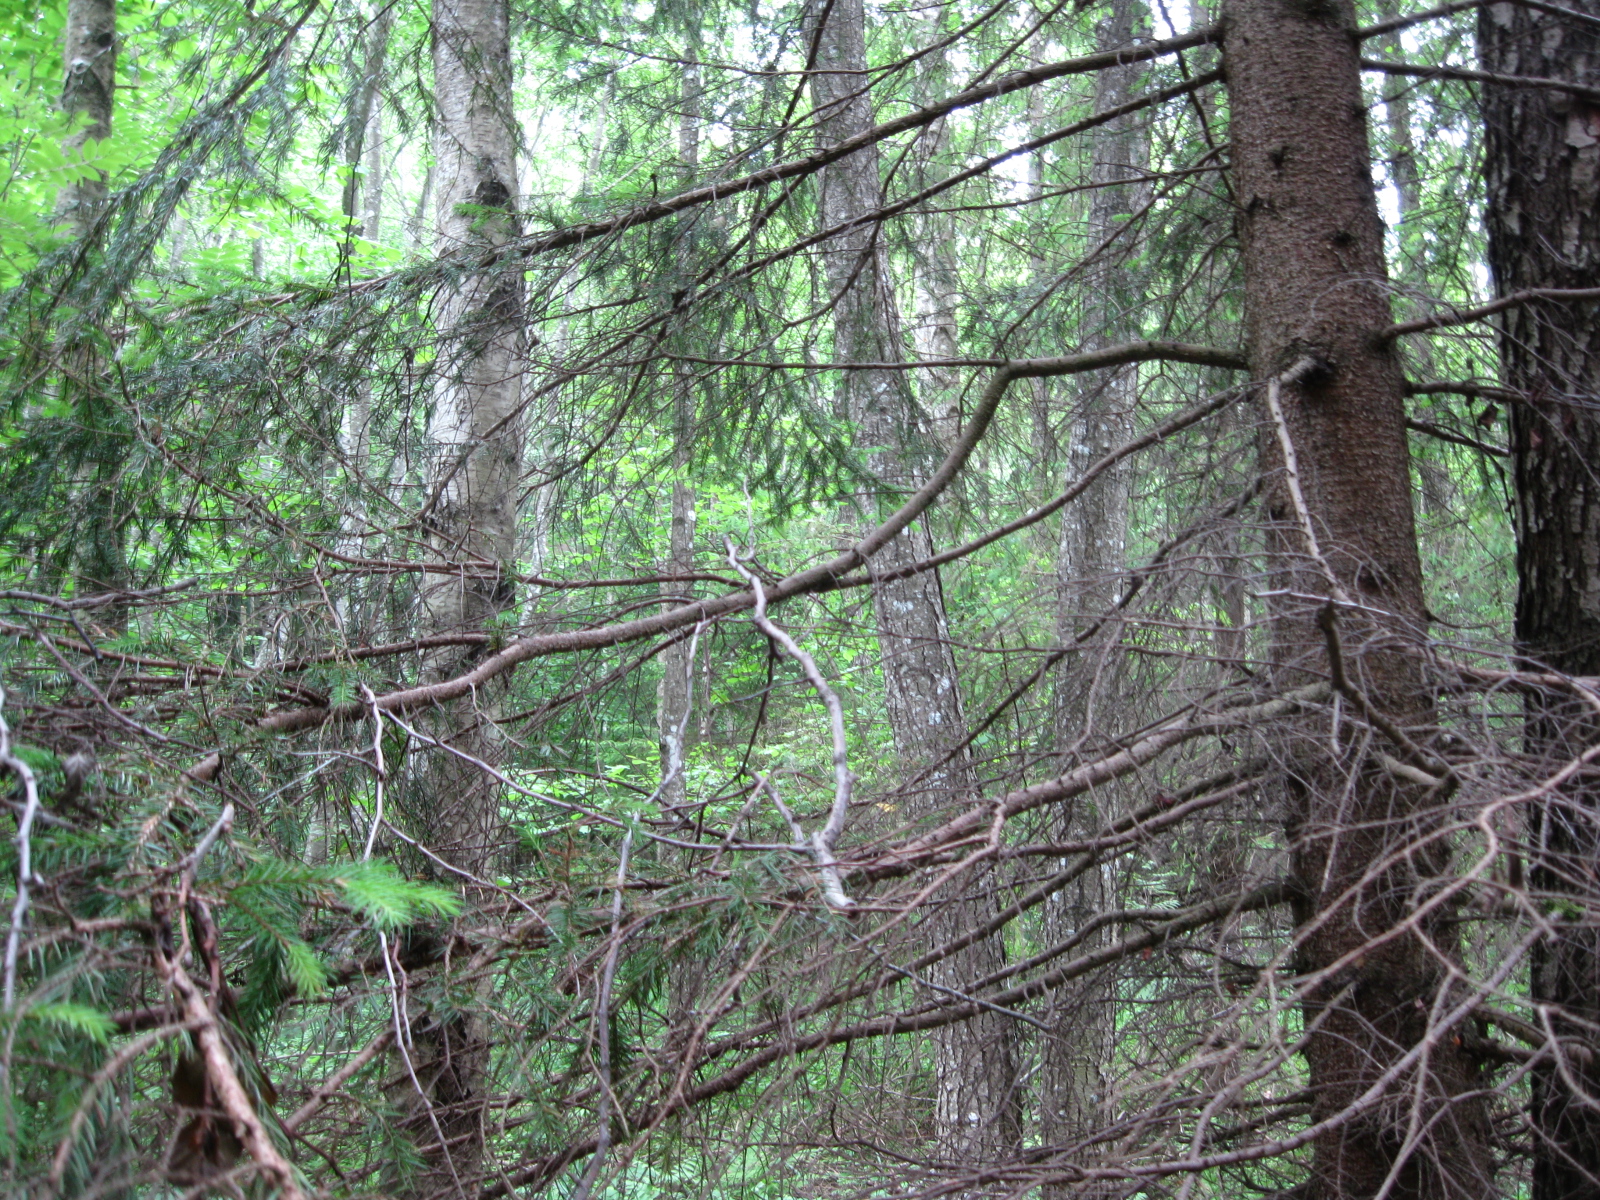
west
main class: Woodland
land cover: Spruce dominated mixed woodland
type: hemiboreal forest and nemoral coniferous forest and mixed broadleaved-coniferous forest
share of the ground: > 75 %
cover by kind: coniferous forest trees 55 %, broadleaved forest trees 30 %, unconsolidated bare surface 10 %, herbaceous plants 5 %
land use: Forestry
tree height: > 5 m
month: June
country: LT
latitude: 55.5198
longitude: 24.2057
